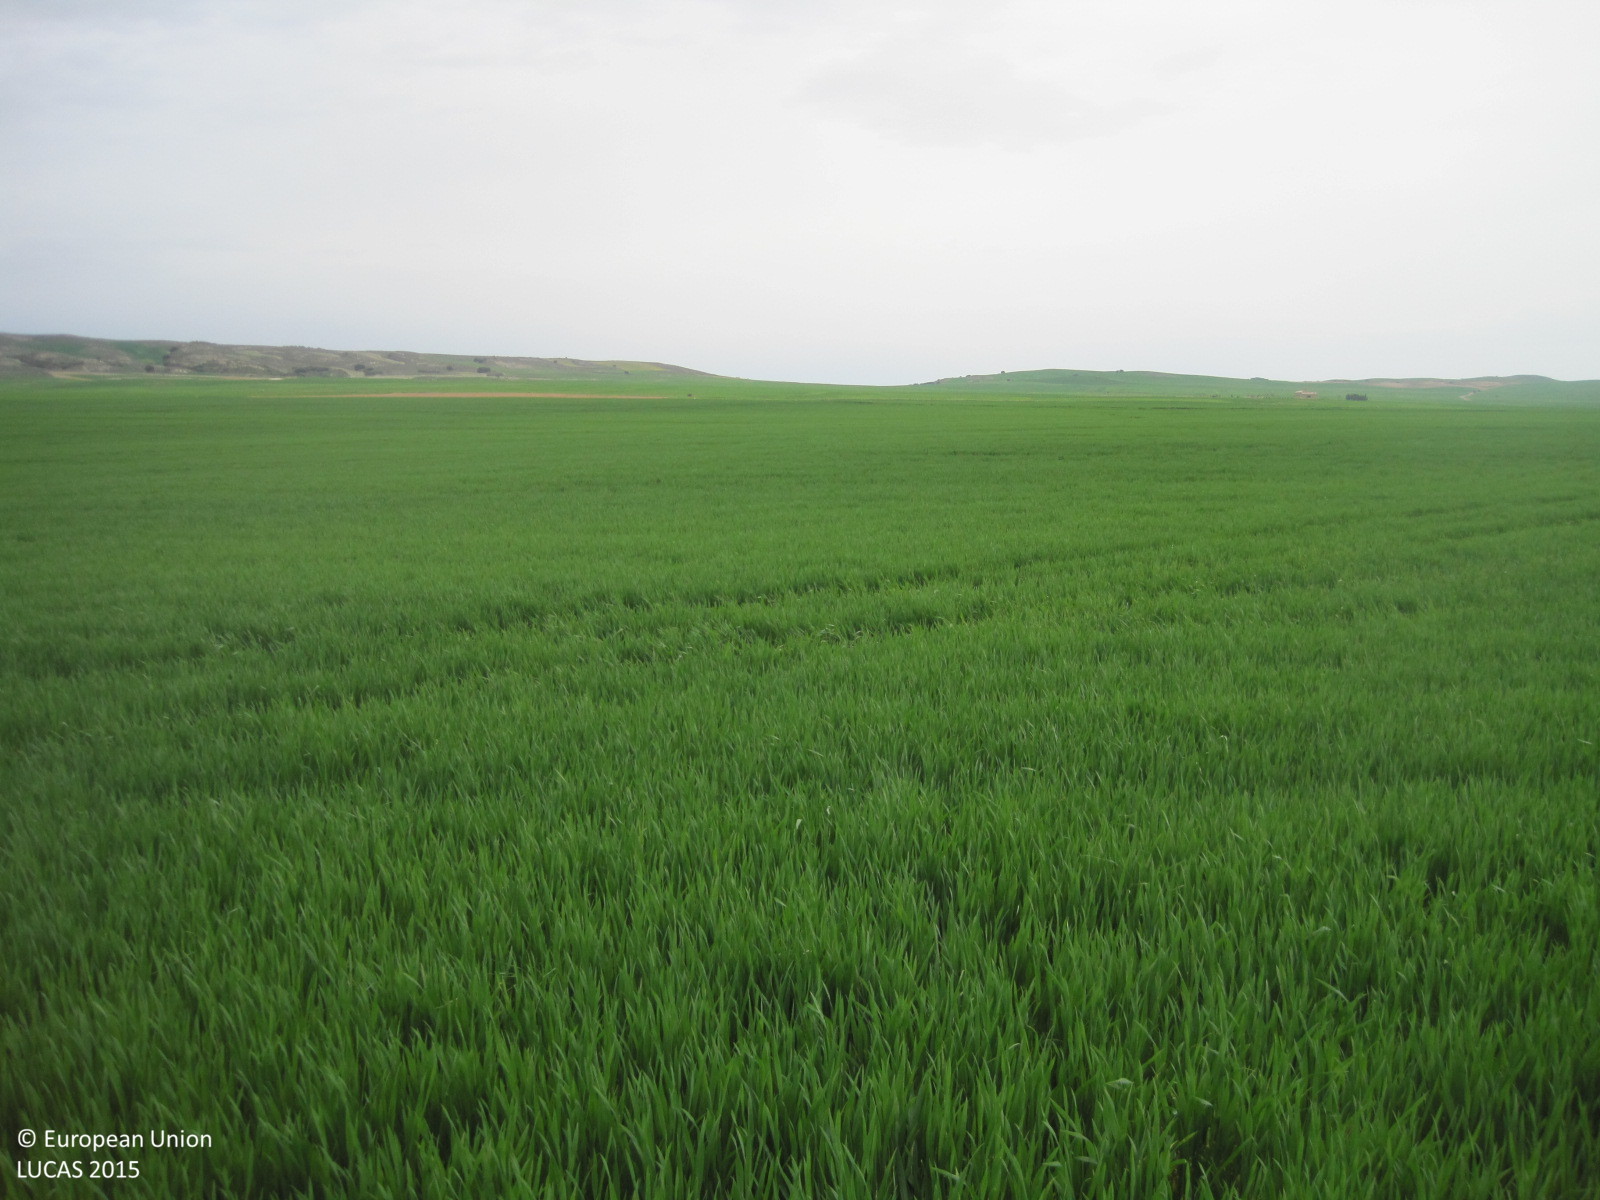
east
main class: Cropland
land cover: Barley
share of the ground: > 75 %
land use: Agriculture (excluding fallow land and kitchen gardens)
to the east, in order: Barley
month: April
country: ES
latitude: 42.5241
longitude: -2.1297
